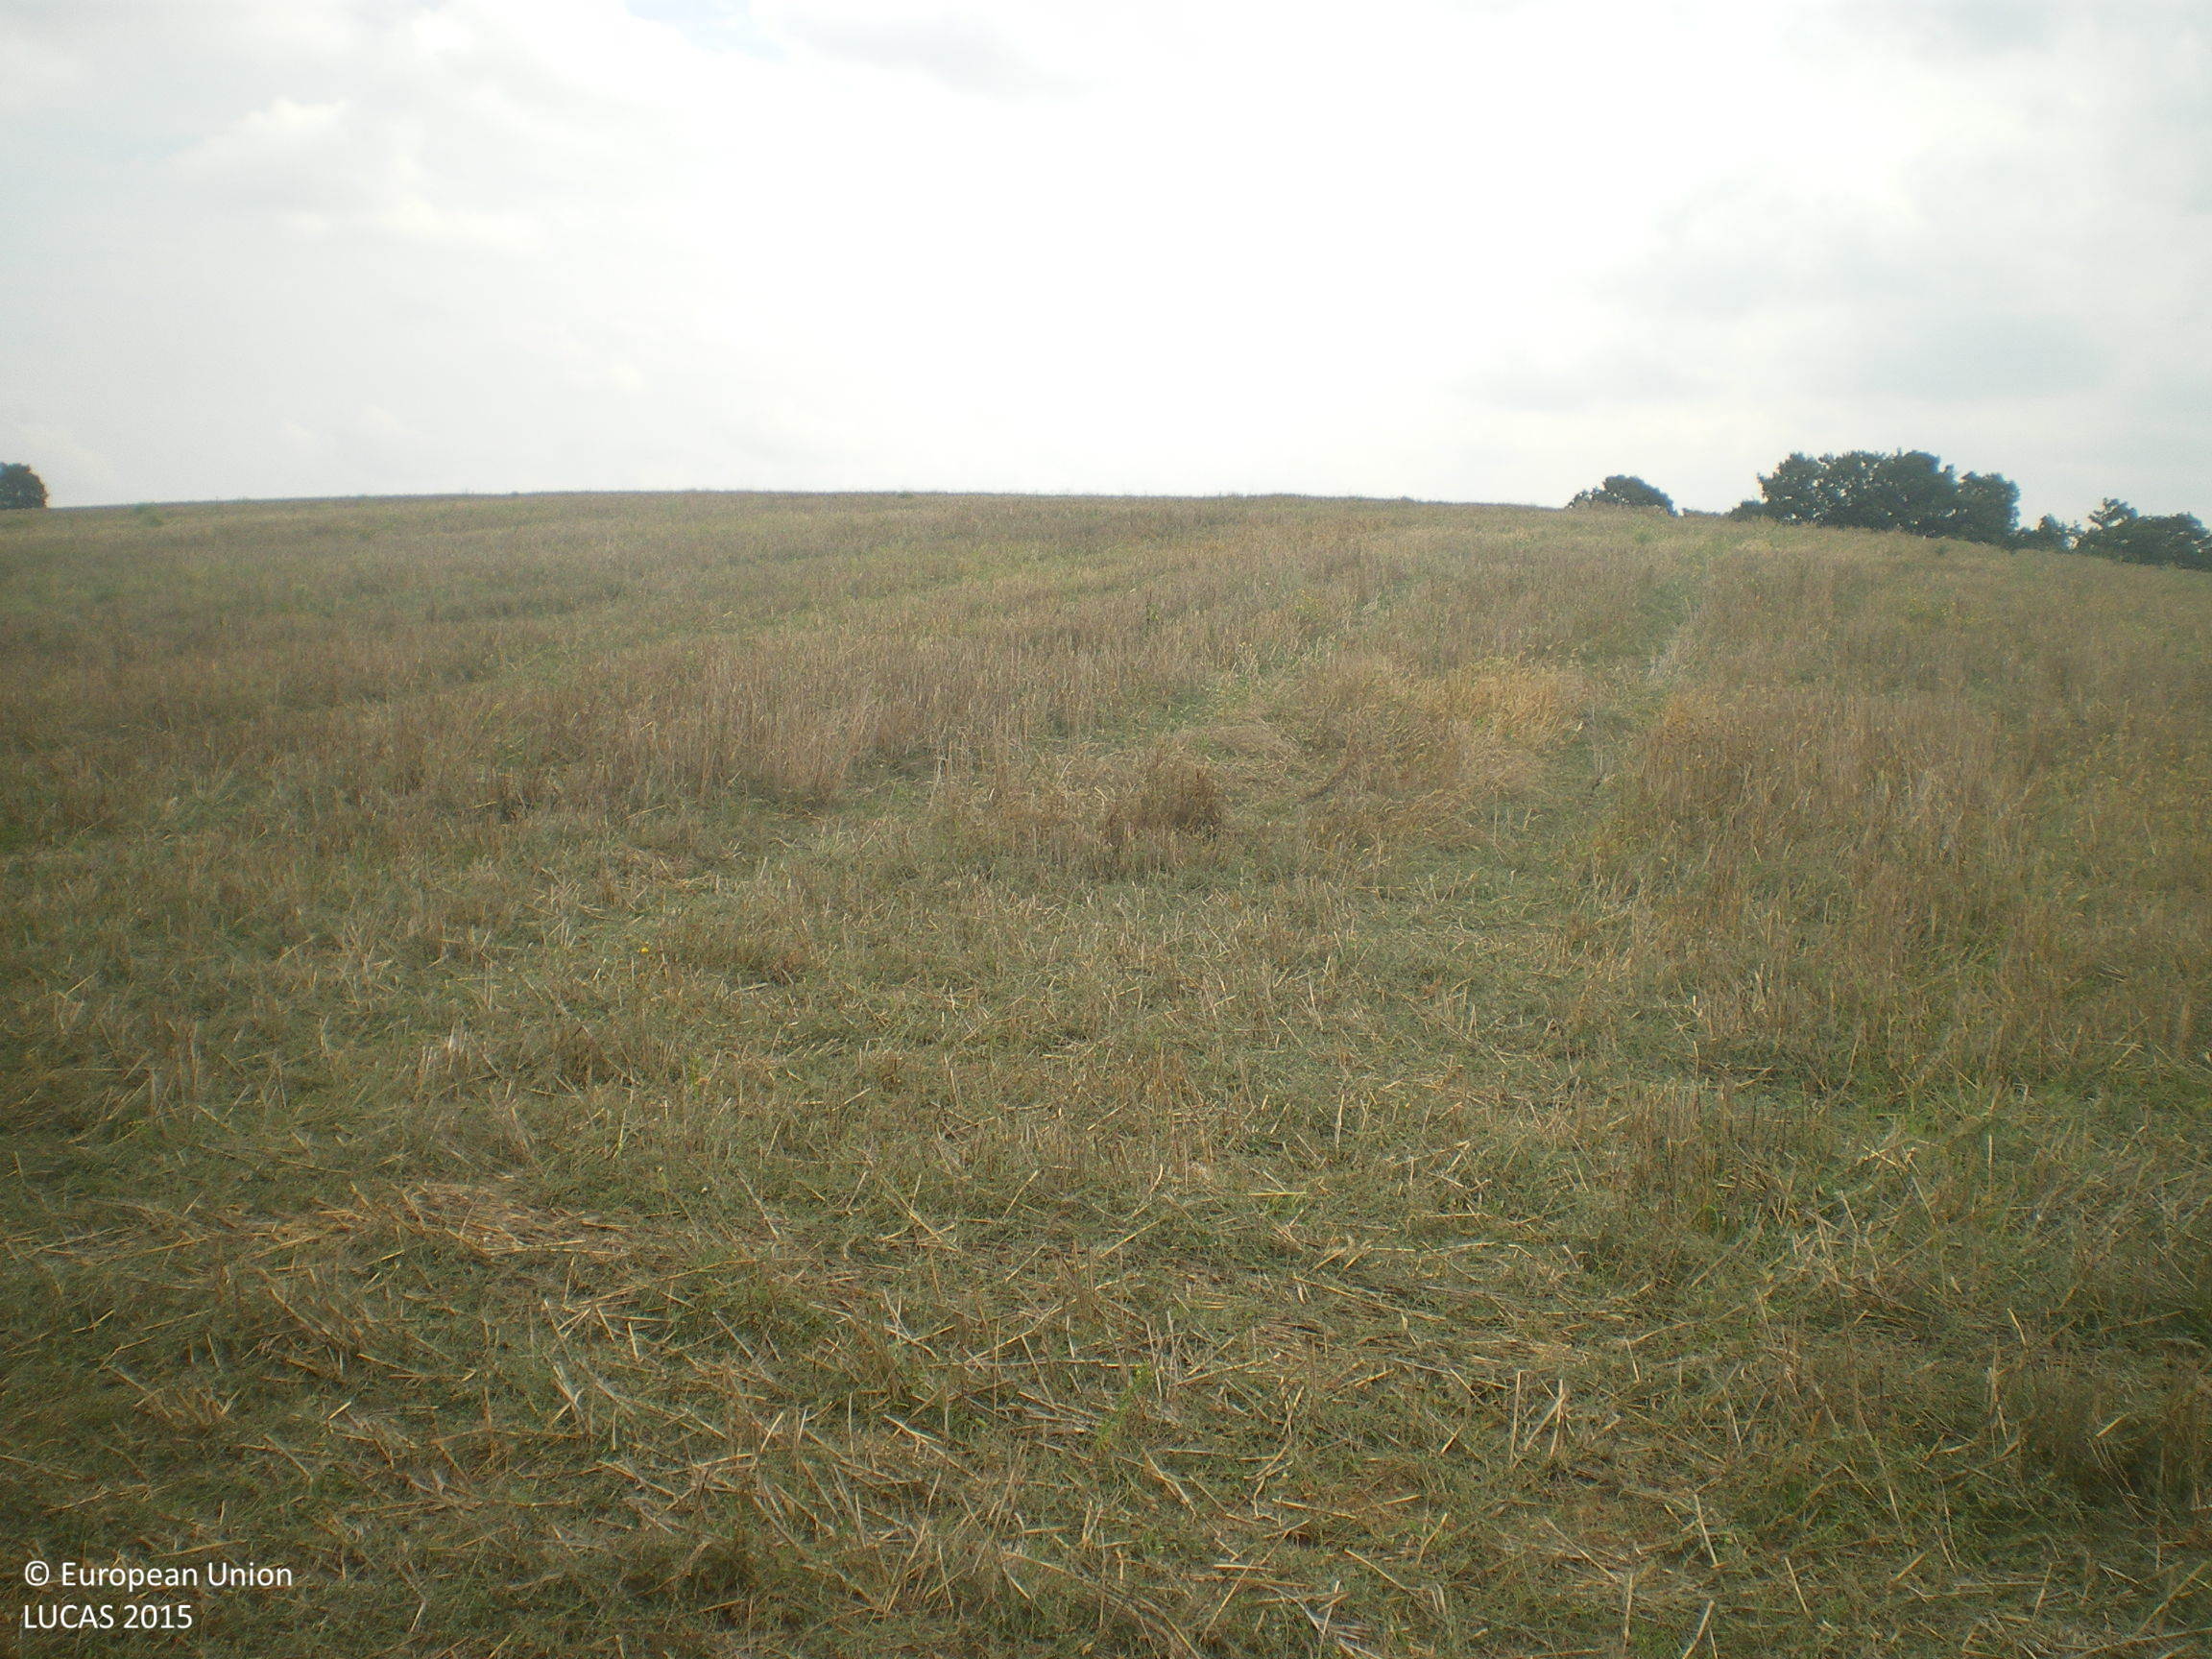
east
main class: Cropland
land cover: Common wheat
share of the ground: 10 - 25 %
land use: Agriculture (excluding fallow land and kitchen gardens)
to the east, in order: Common wheat
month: September
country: BG
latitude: 42.0404
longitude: 25.9599
